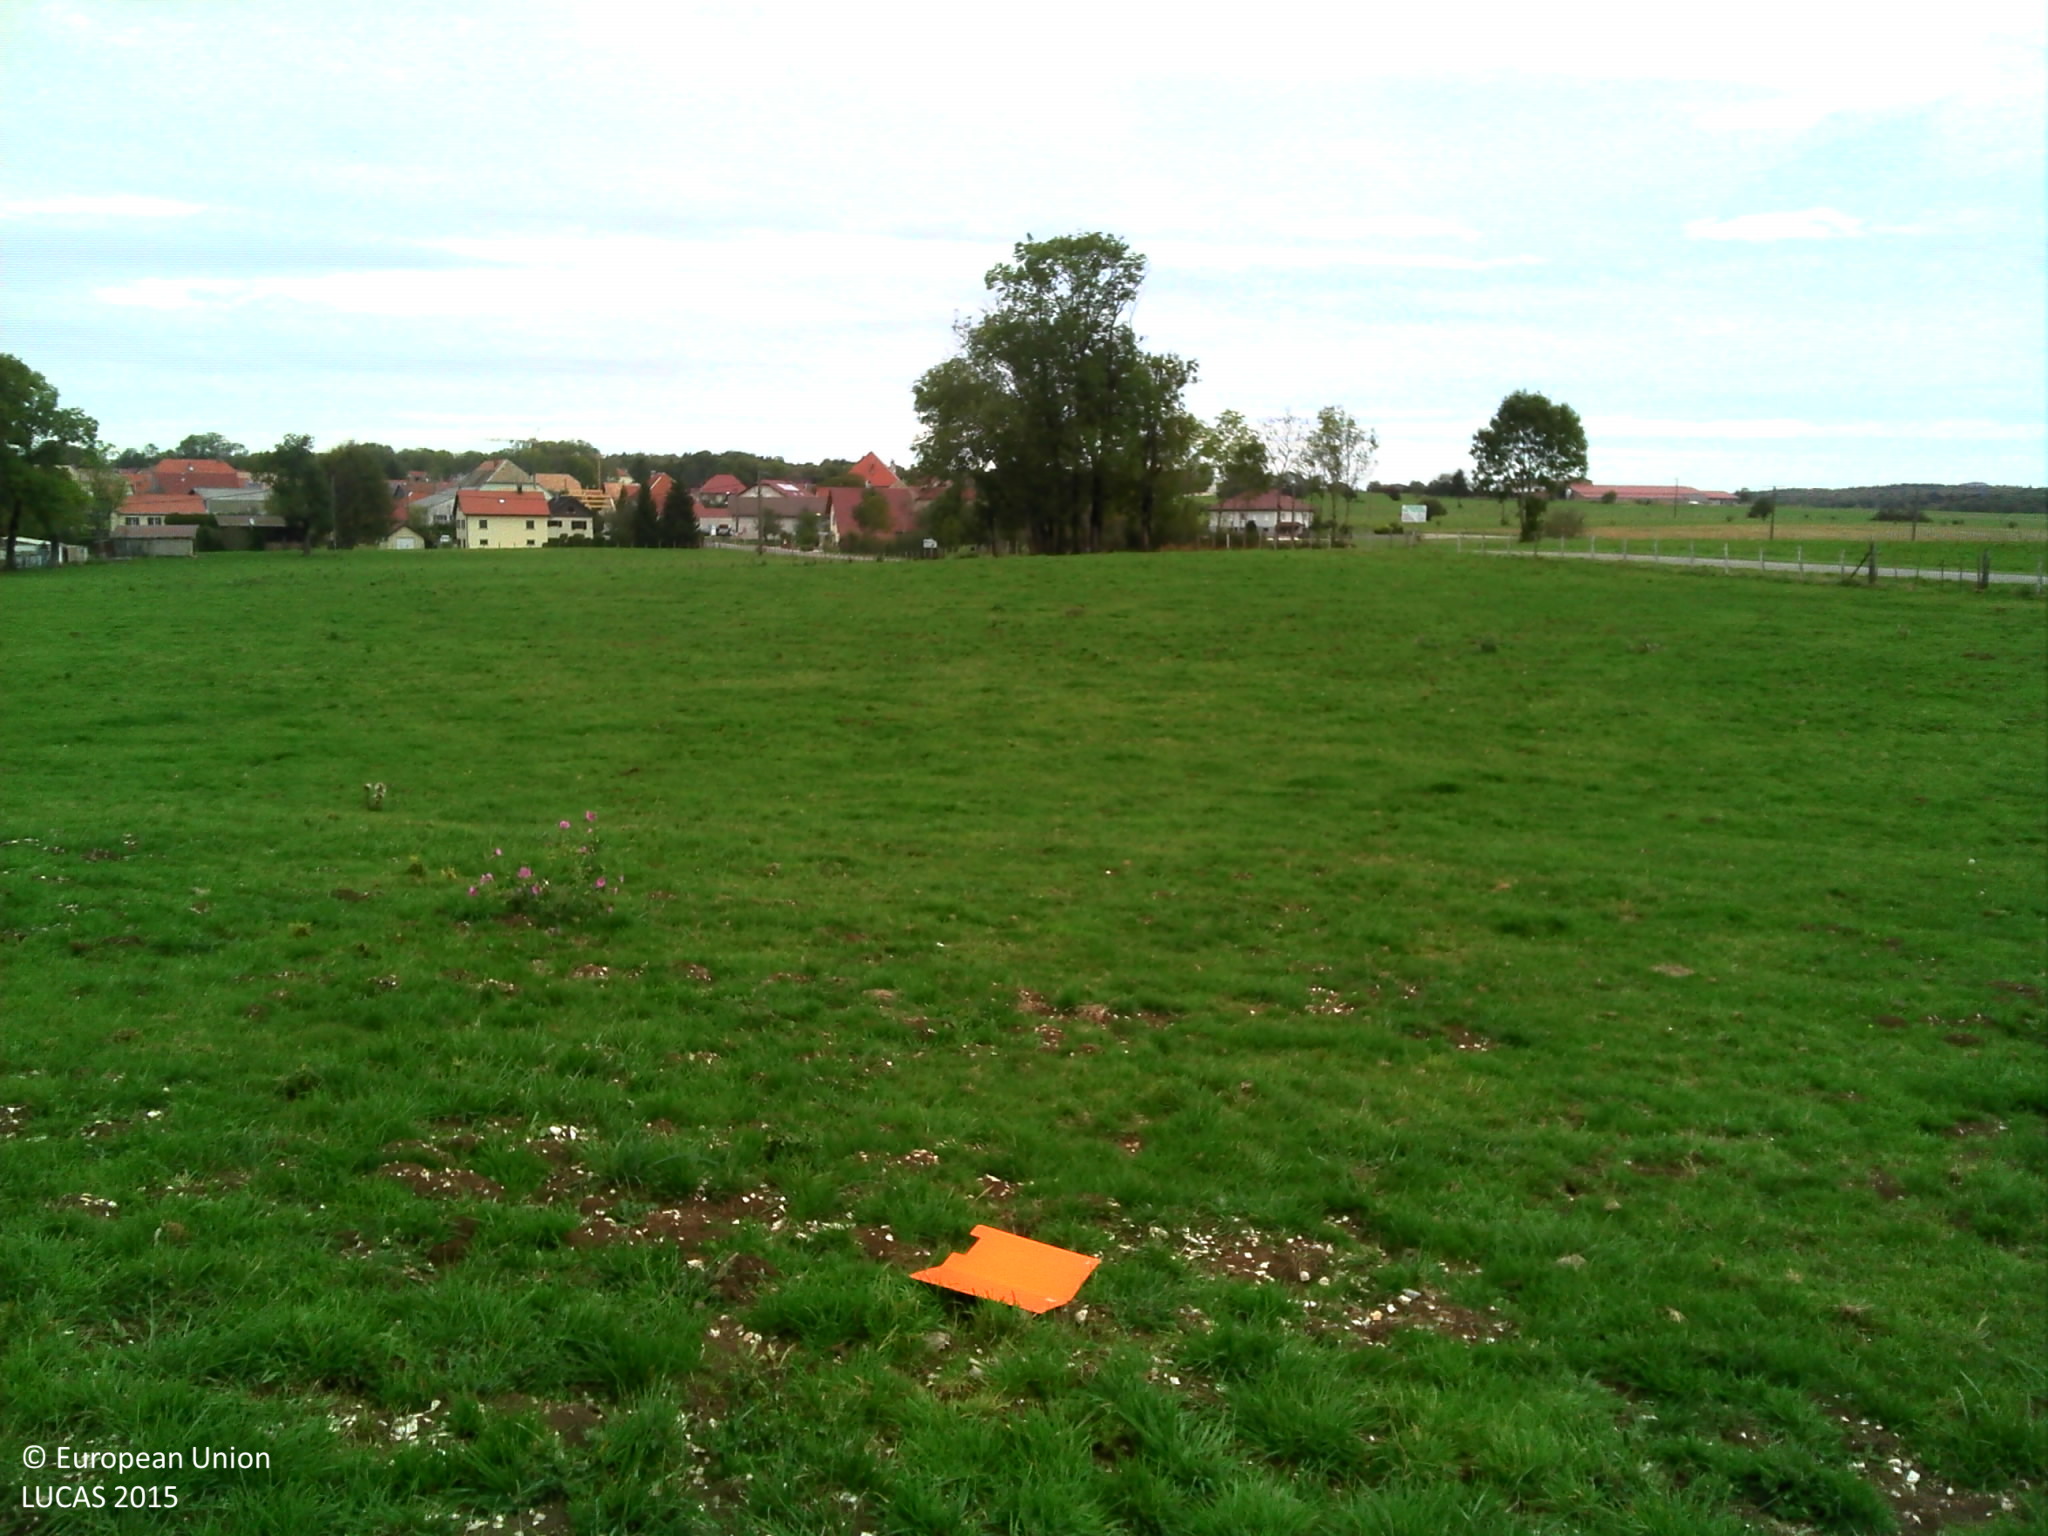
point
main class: Grassland
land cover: Grassland without tree/shrub cover
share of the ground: > 75 %
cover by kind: herbaceous plants 100 %
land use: Agriculture (excluding fallow land and kitchen gardens)
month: October
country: FR
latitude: 47.0390
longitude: 6.1460
